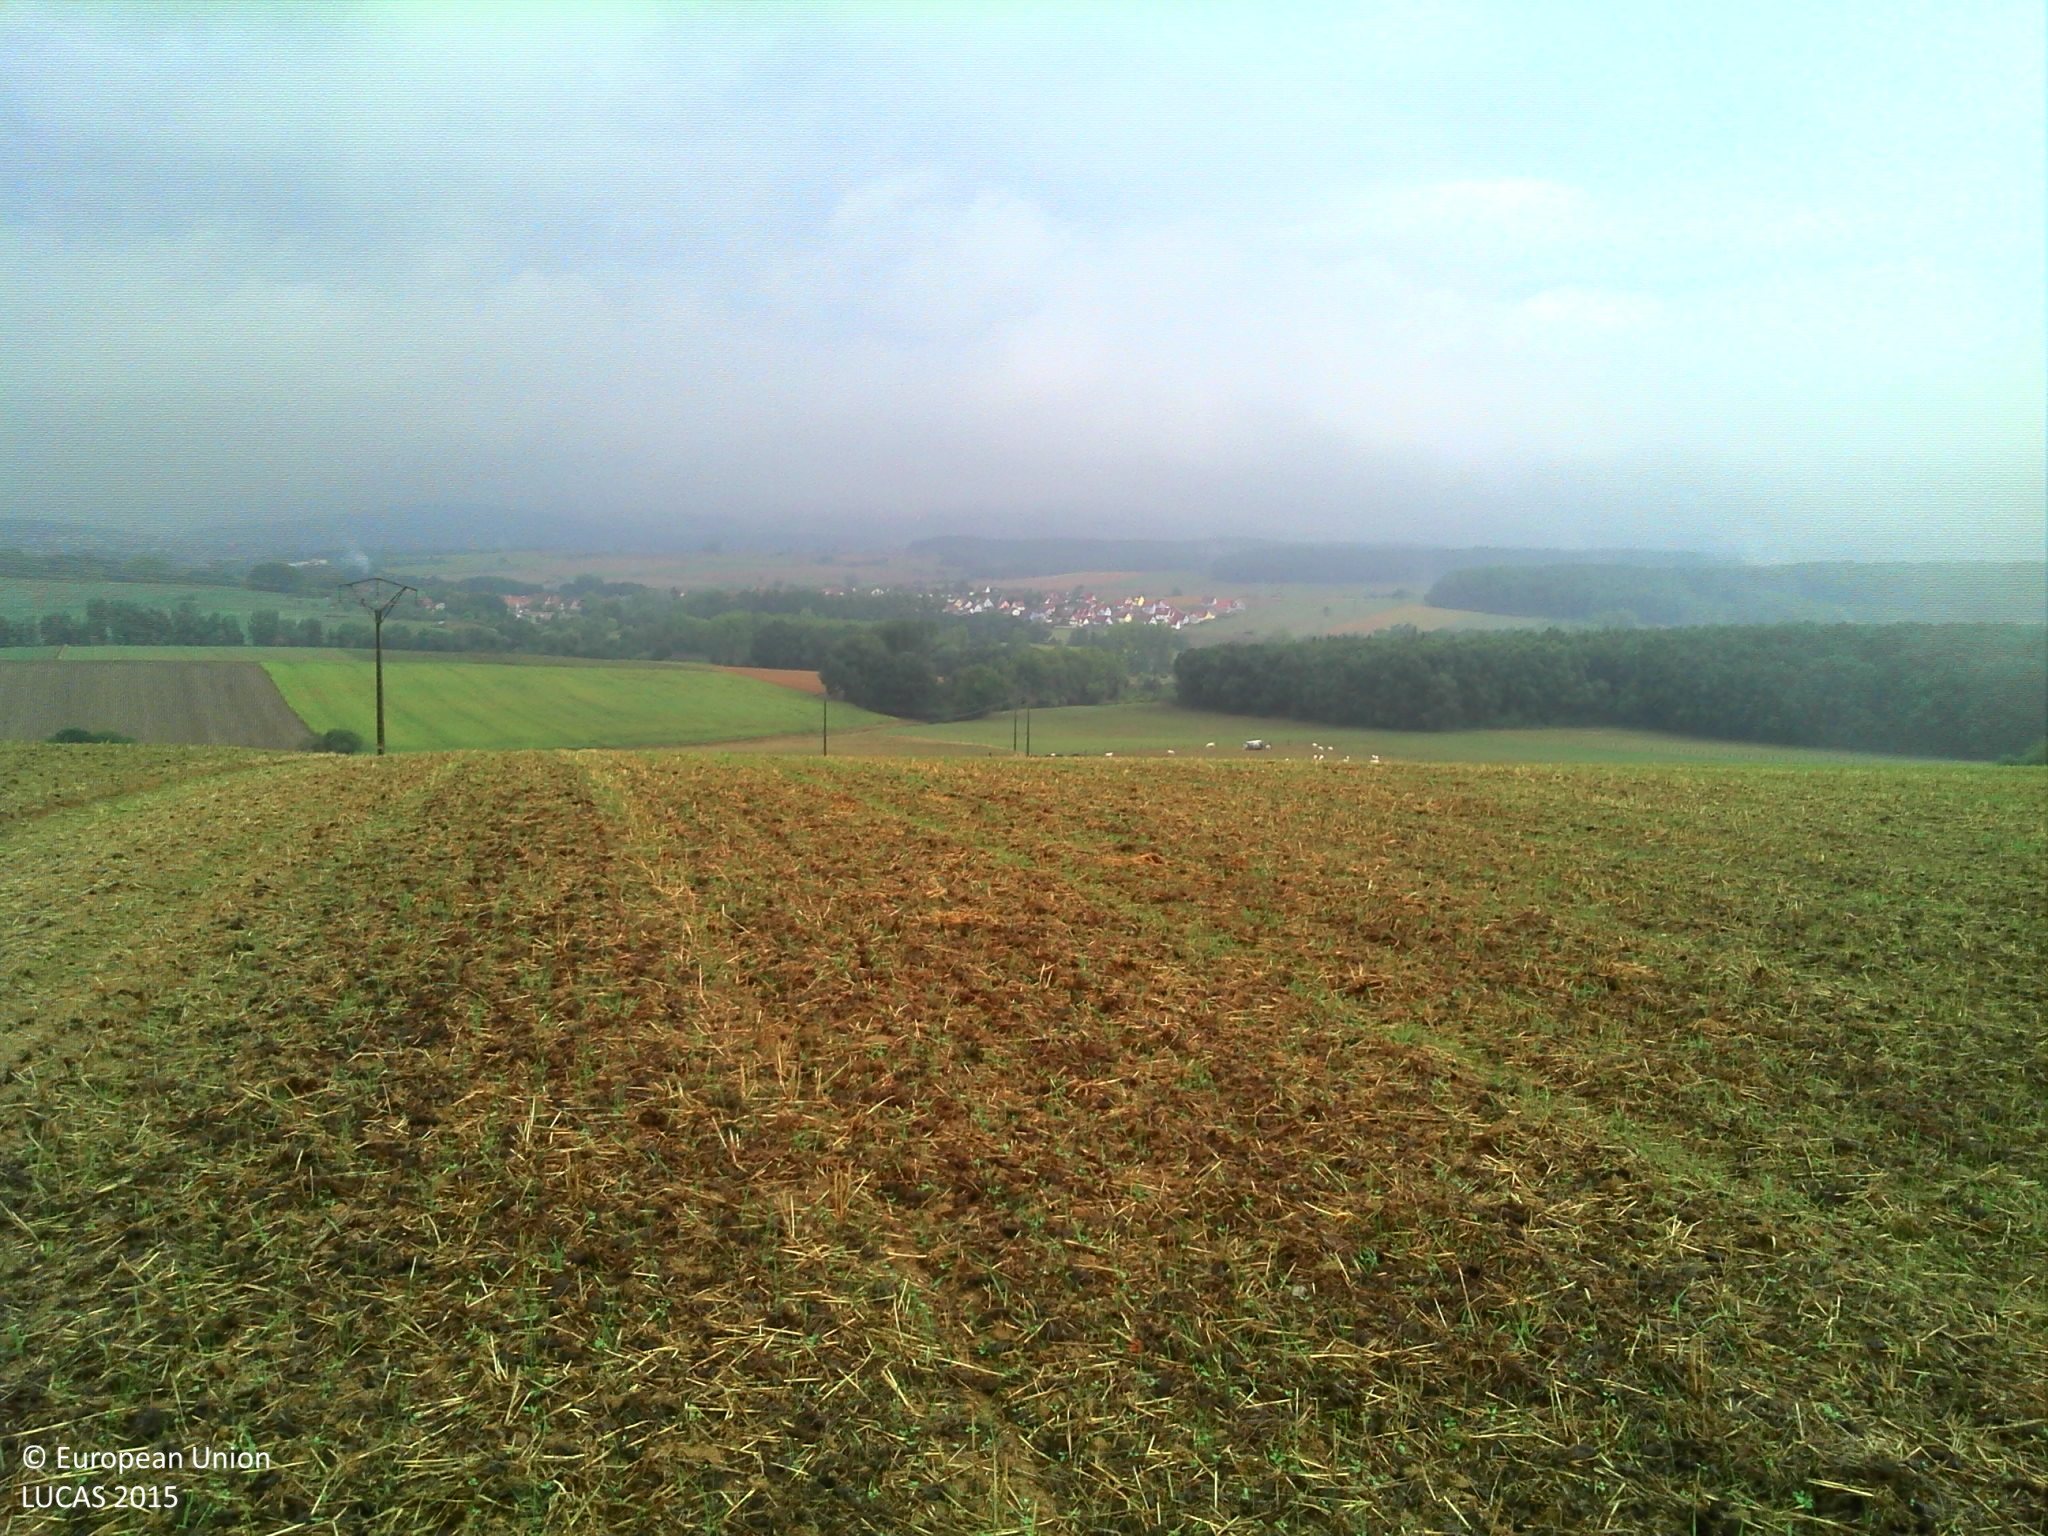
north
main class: Cropland
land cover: Common wheat
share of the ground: 10 - 25 %
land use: Agriculture (excluding fallow land and kitchen gardens)
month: August
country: FR
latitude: 48.8434
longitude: 7.5071
